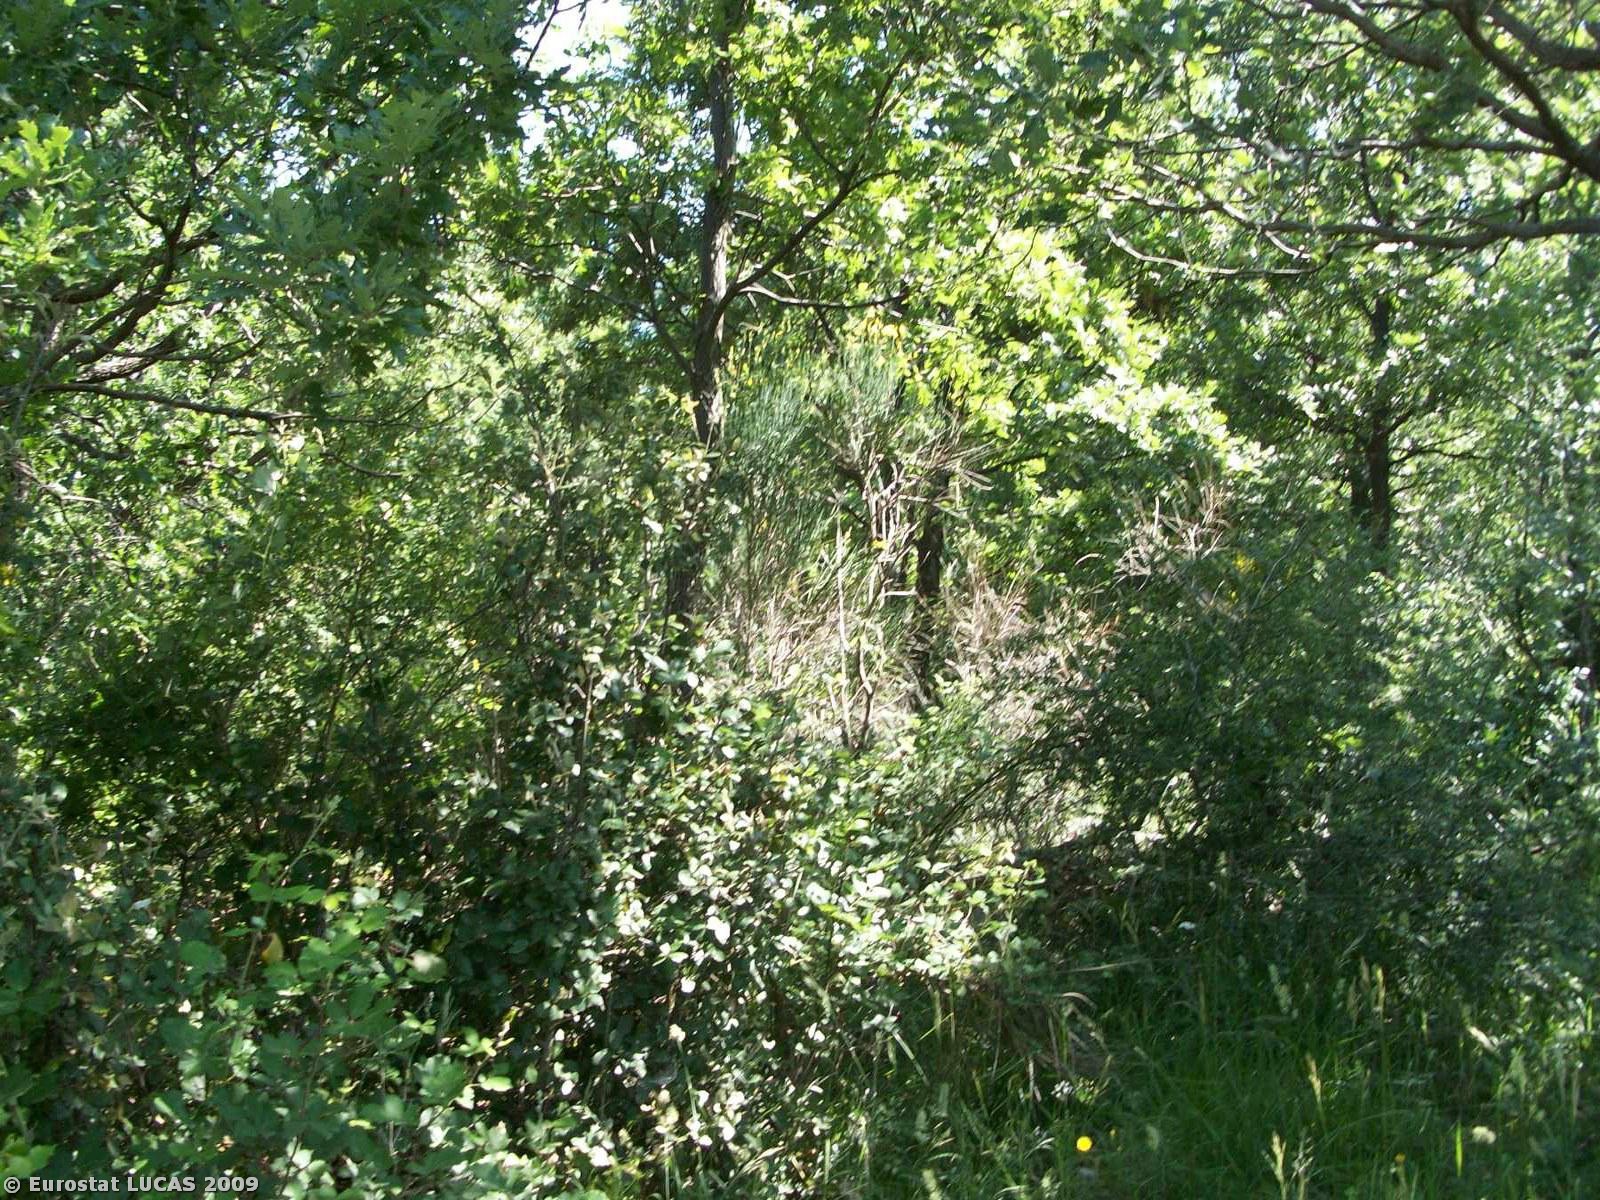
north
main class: Woodland
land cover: Broadleaved woodland
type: mesophytic deciduous forest
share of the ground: > 75 %
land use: Agriculture (excluding fallow land and kitchen gardens)
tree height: > 5 m
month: June
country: IT
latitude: 39.7009
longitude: 16.0251
